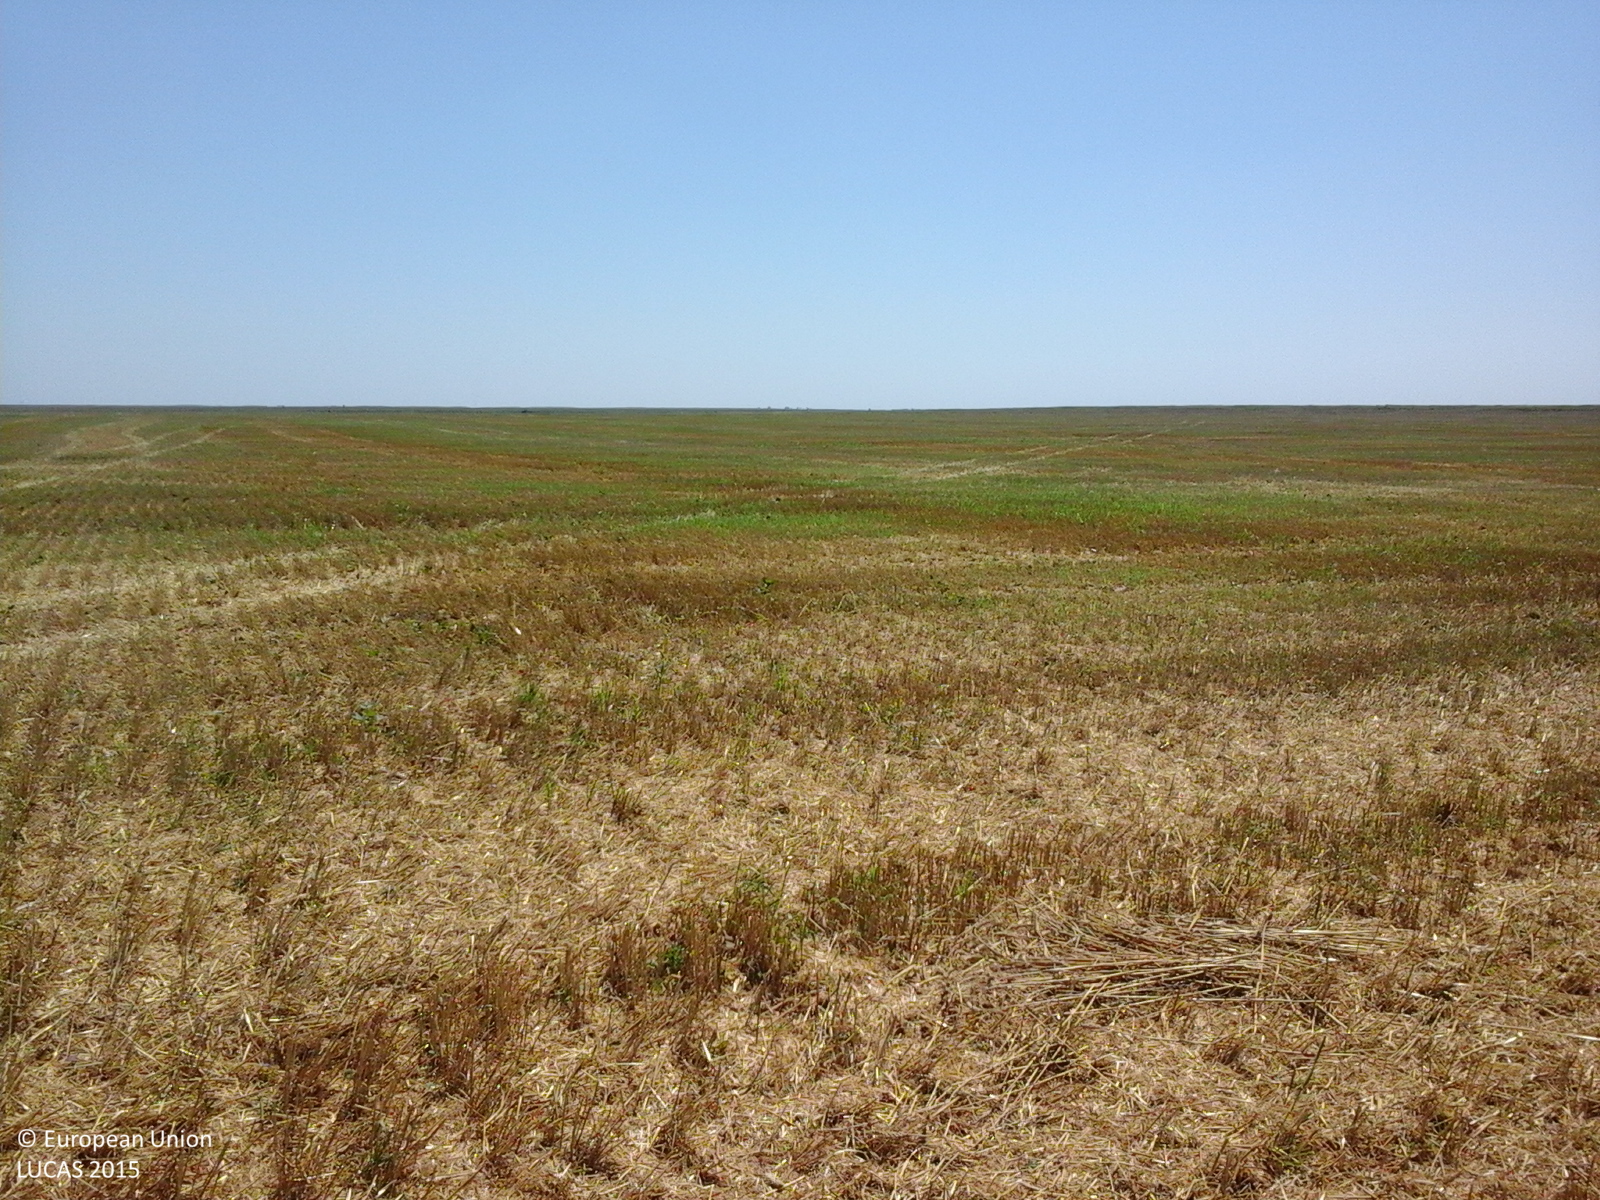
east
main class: Cropland
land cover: Common wheat
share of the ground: 10 - 25 %
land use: Agriculture (excluding fallow land and kitchen gardens)
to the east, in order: Common wheat
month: July
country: RO
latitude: 44.3016
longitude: 26.5219
